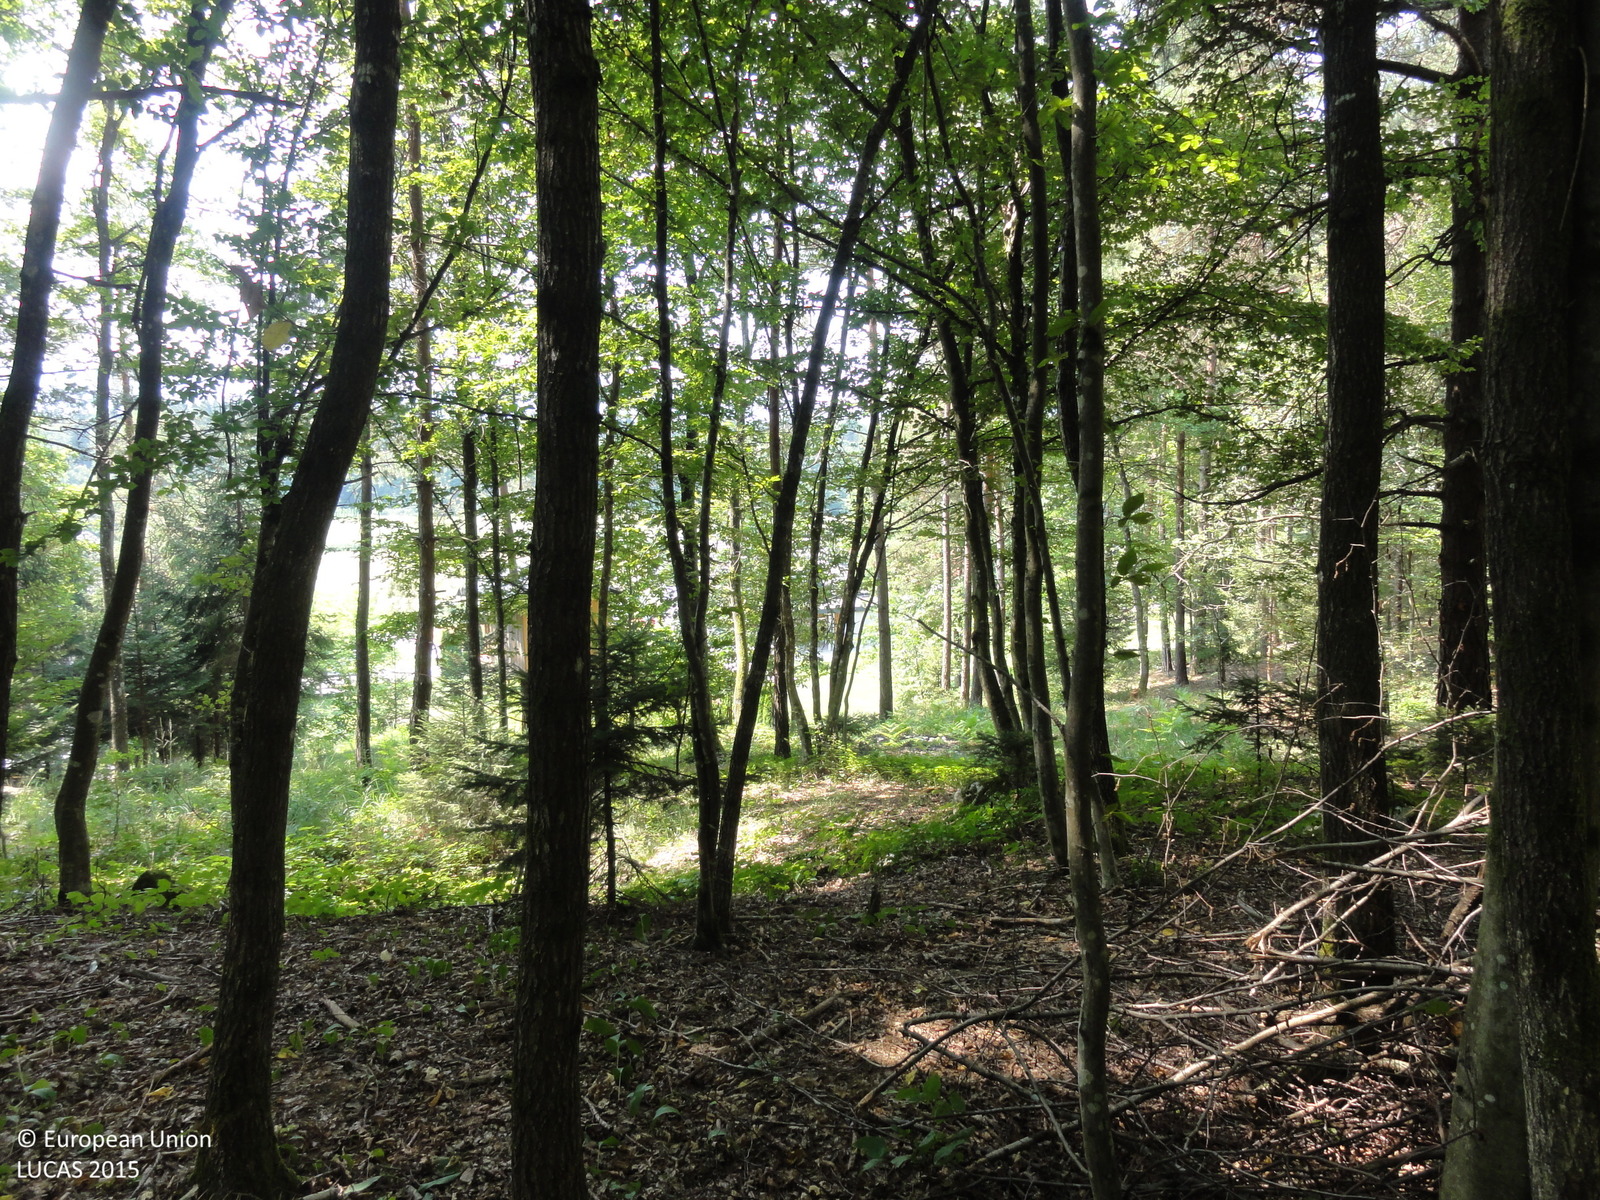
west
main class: Woodland
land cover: Spruce dominated mixed woodland
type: mountainous beech forest
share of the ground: > 75 %
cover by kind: broadleaved forest trees 65 %, coniferous forest trees 35 %
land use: Forestry
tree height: > 5 m
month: August
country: SI
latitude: 45.7782
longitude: 15.1023
